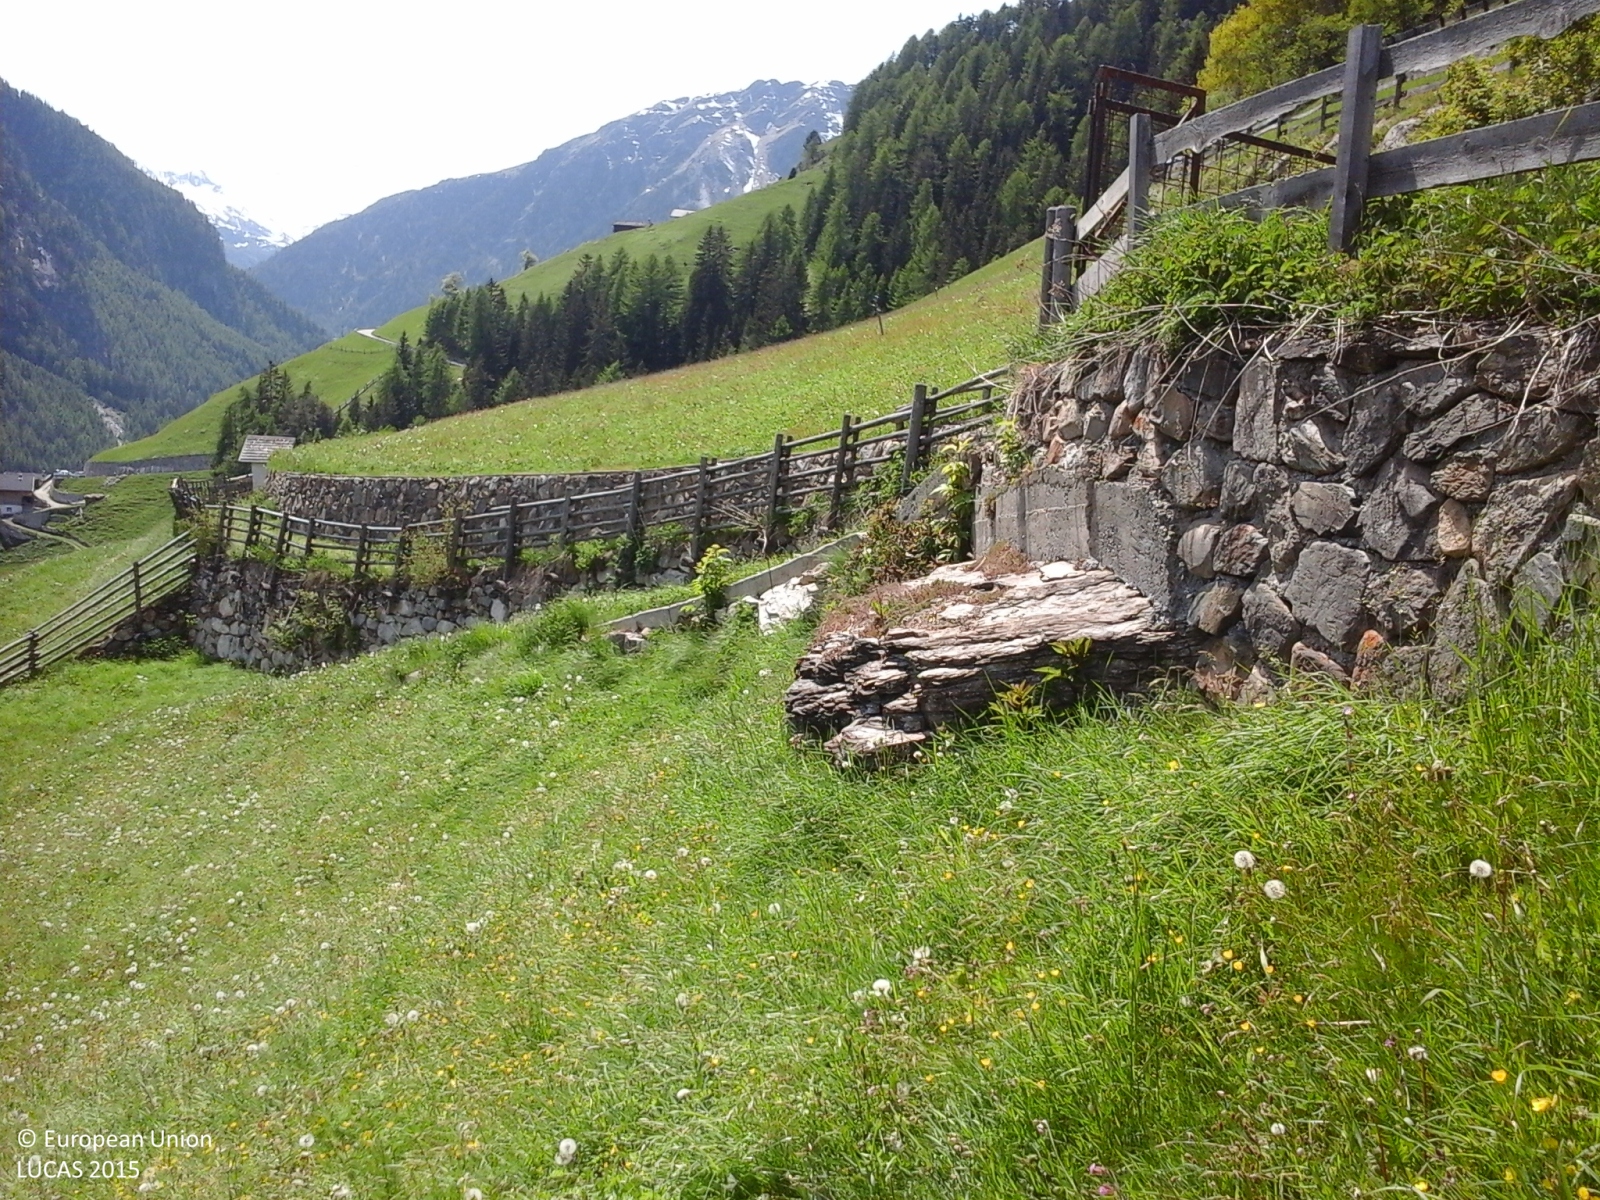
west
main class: Grassland
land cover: Grassland without tree/shrub cover
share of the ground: > 75 %
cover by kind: herbaceous plants 100 %
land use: Agriculture (excluding fallow land and kitchen gardens)
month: May
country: IT
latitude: 46.5466
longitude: 10.7685
